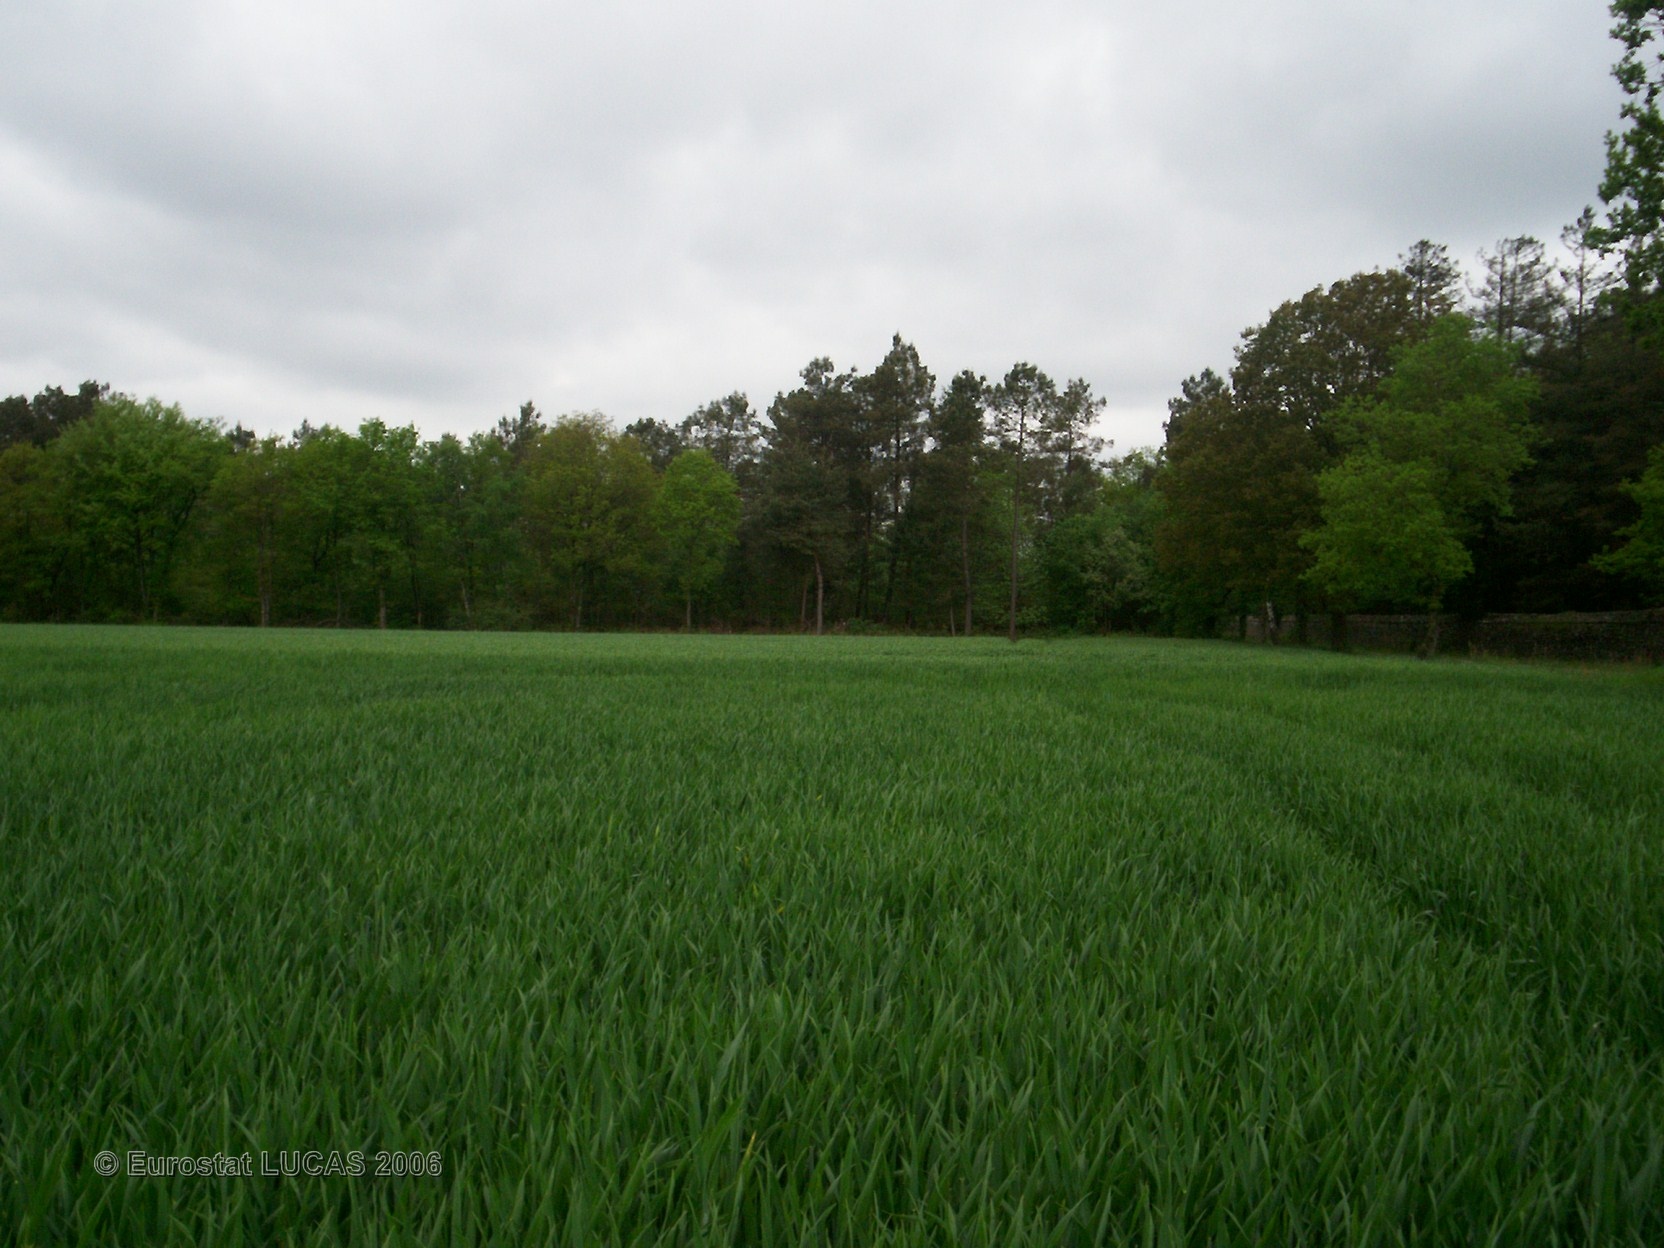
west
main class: Cropland
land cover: Common wheat
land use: Agriculture (excluding fallow land and kitchen gardens)
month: May
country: FR
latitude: 47.8815
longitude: -2.2641
